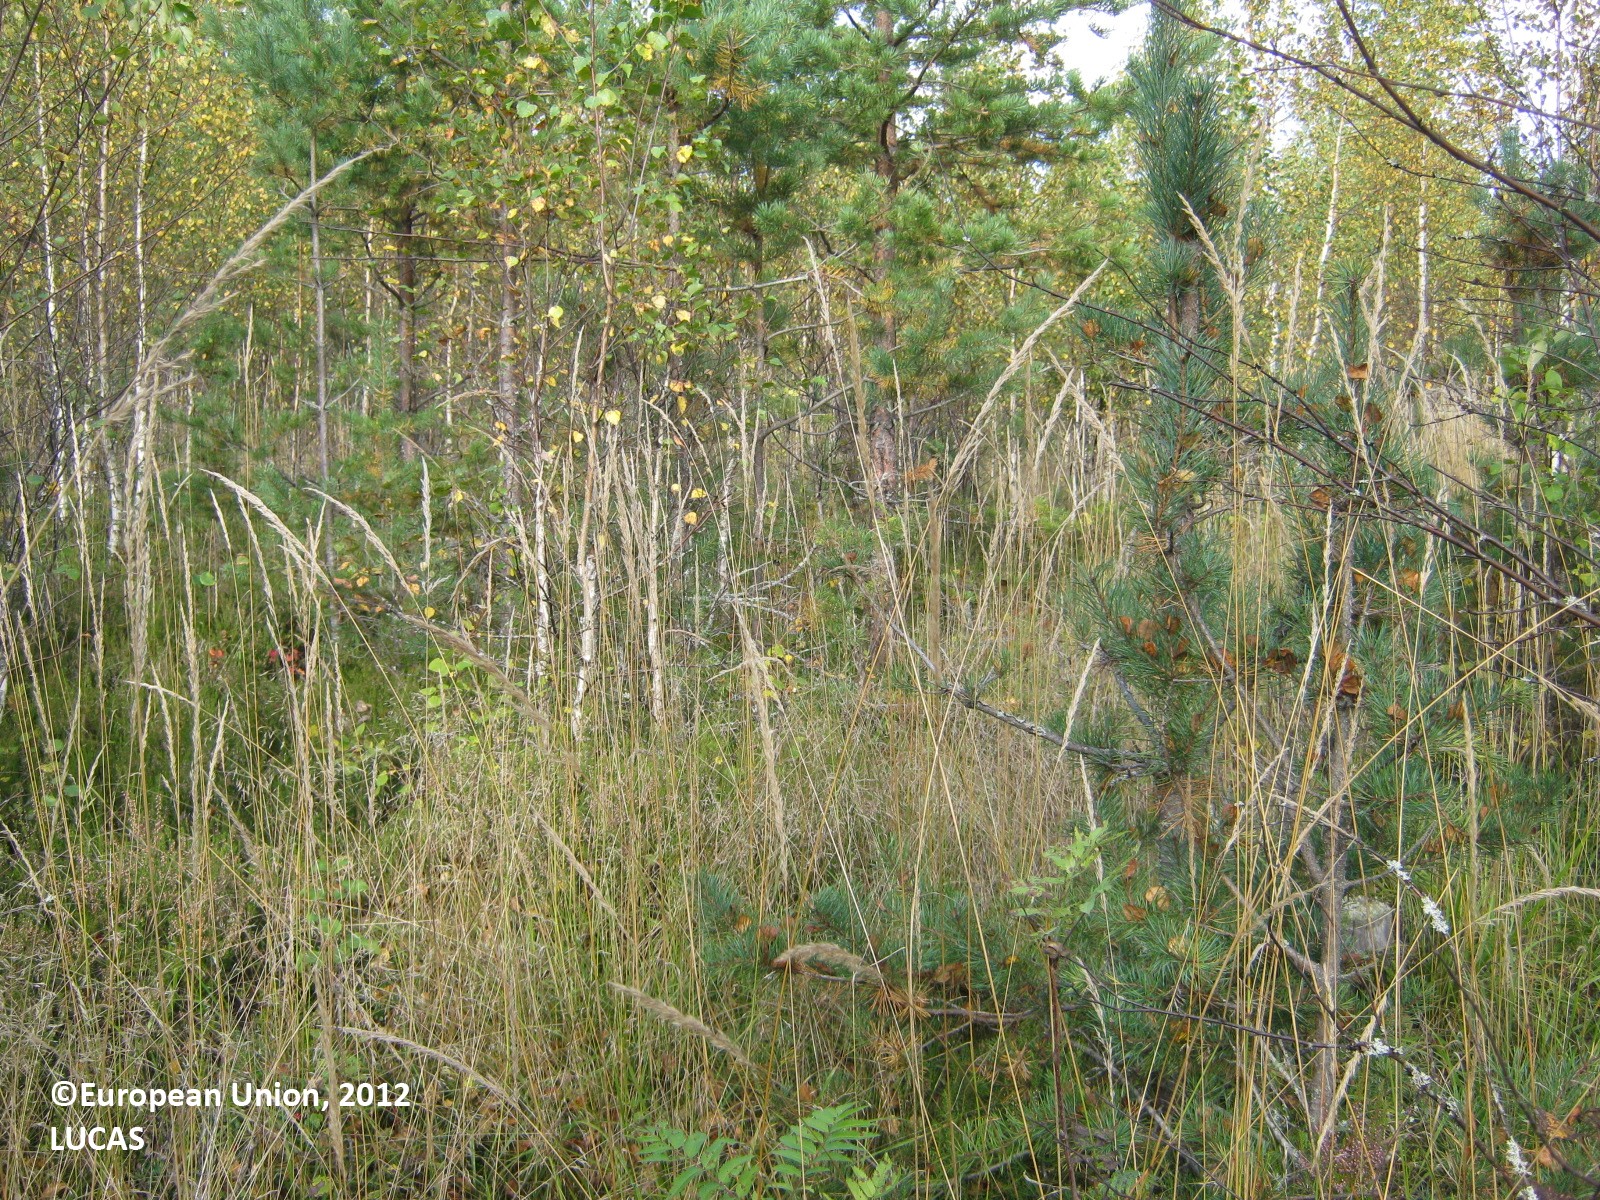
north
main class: Woodland
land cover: Other mixed woodland
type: boreal forest
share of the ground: 50 - 75 %
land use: Forestry
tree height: > 5 m
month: September
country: FI
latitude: 60.9564
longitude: 28.1341
